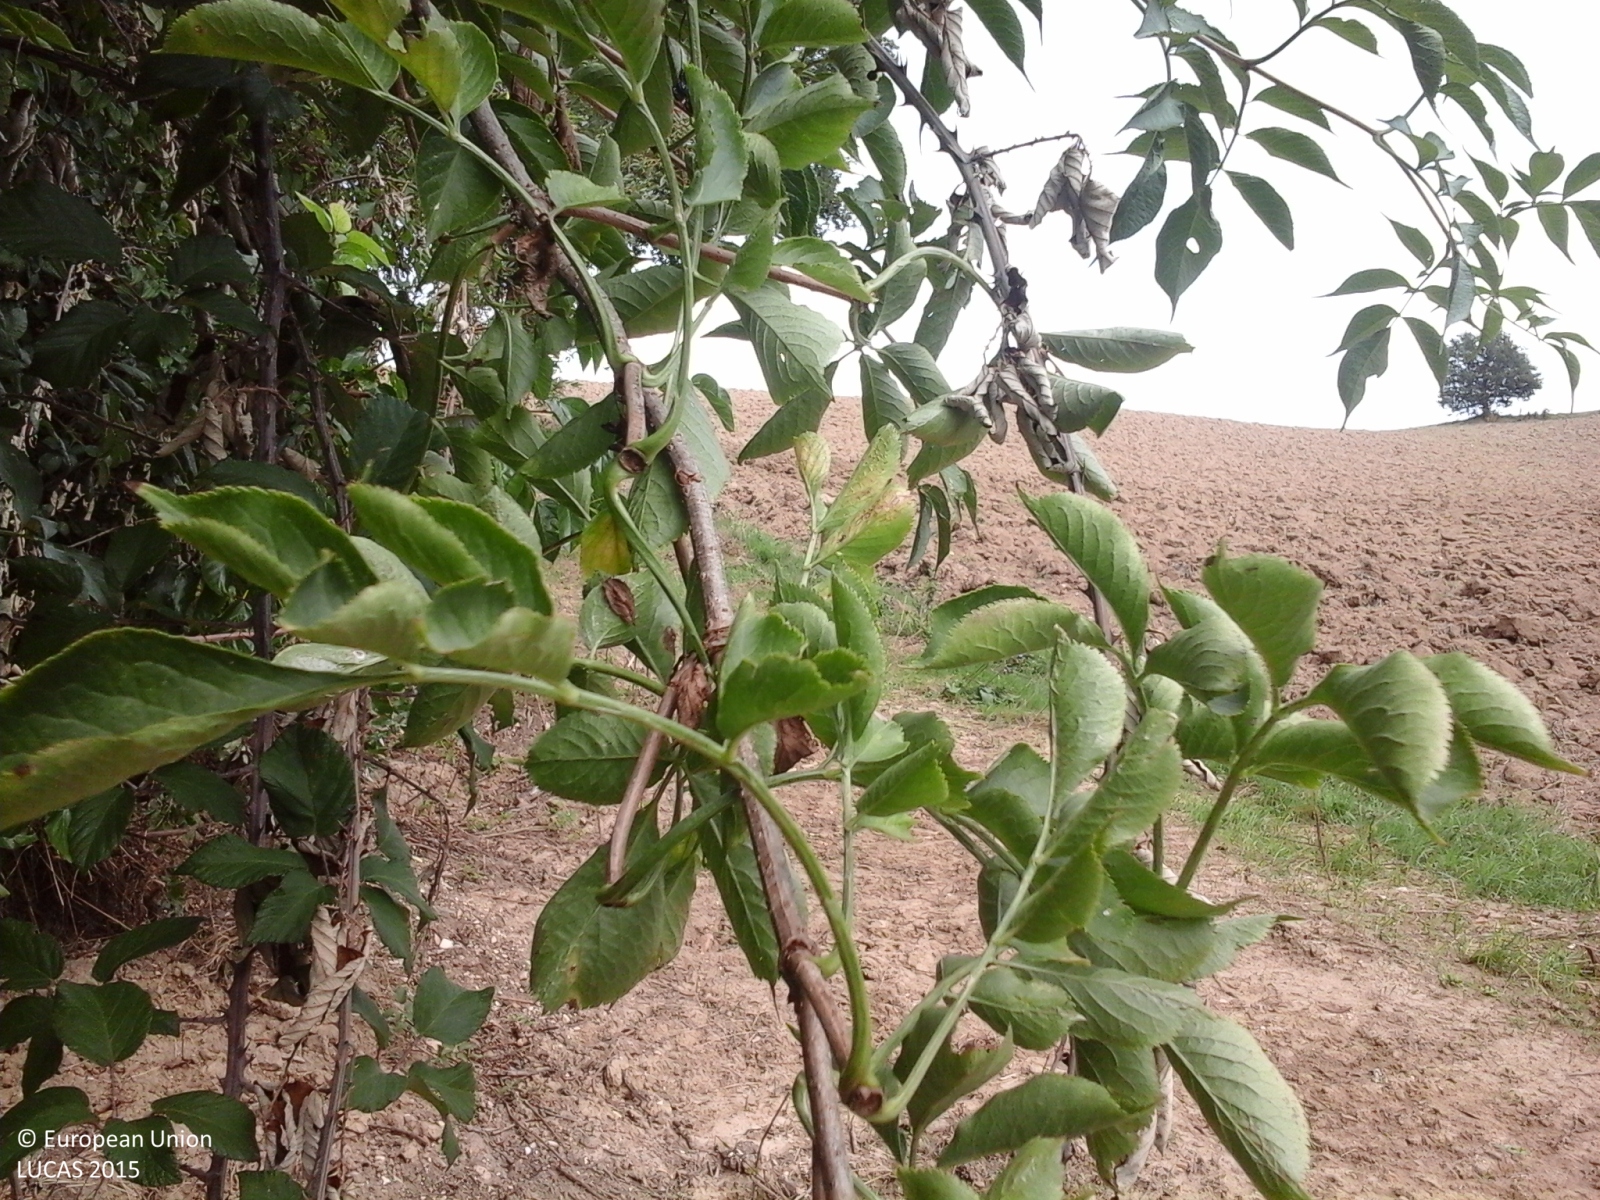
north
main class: Woodland
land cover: Broadleaved woodland
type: thermophilous deciduous forest
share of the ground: 50 - 75 %
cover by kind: broadleaved forest trees 95 %, shrubs 5 %
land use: Forestry
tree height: > 5 m
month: August
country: IT
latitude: 43.3462
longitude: 13.1376
